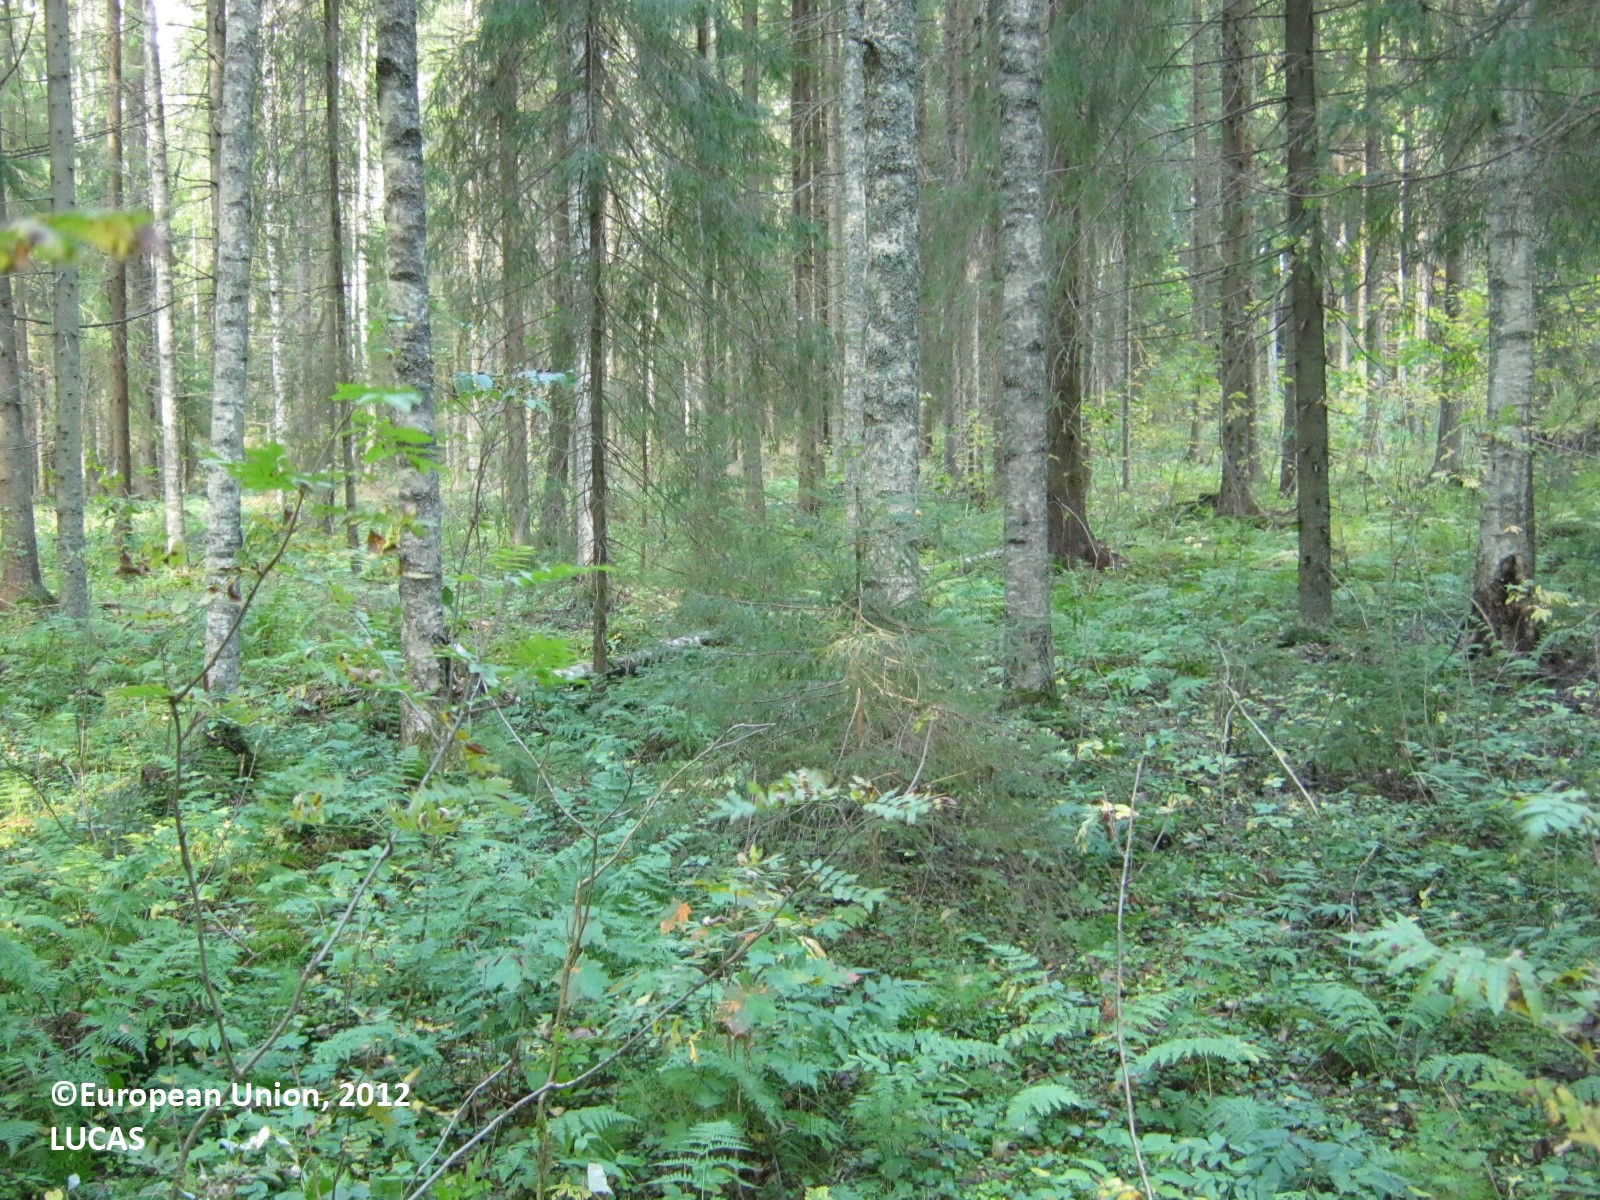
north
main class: Woodland
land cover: Other coniferous woodland
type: boreal forest
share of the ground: 50 - 75 %
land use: Forestry
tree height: > 5 m
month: September
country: FI
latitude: 60.9234
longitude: 27.8095
